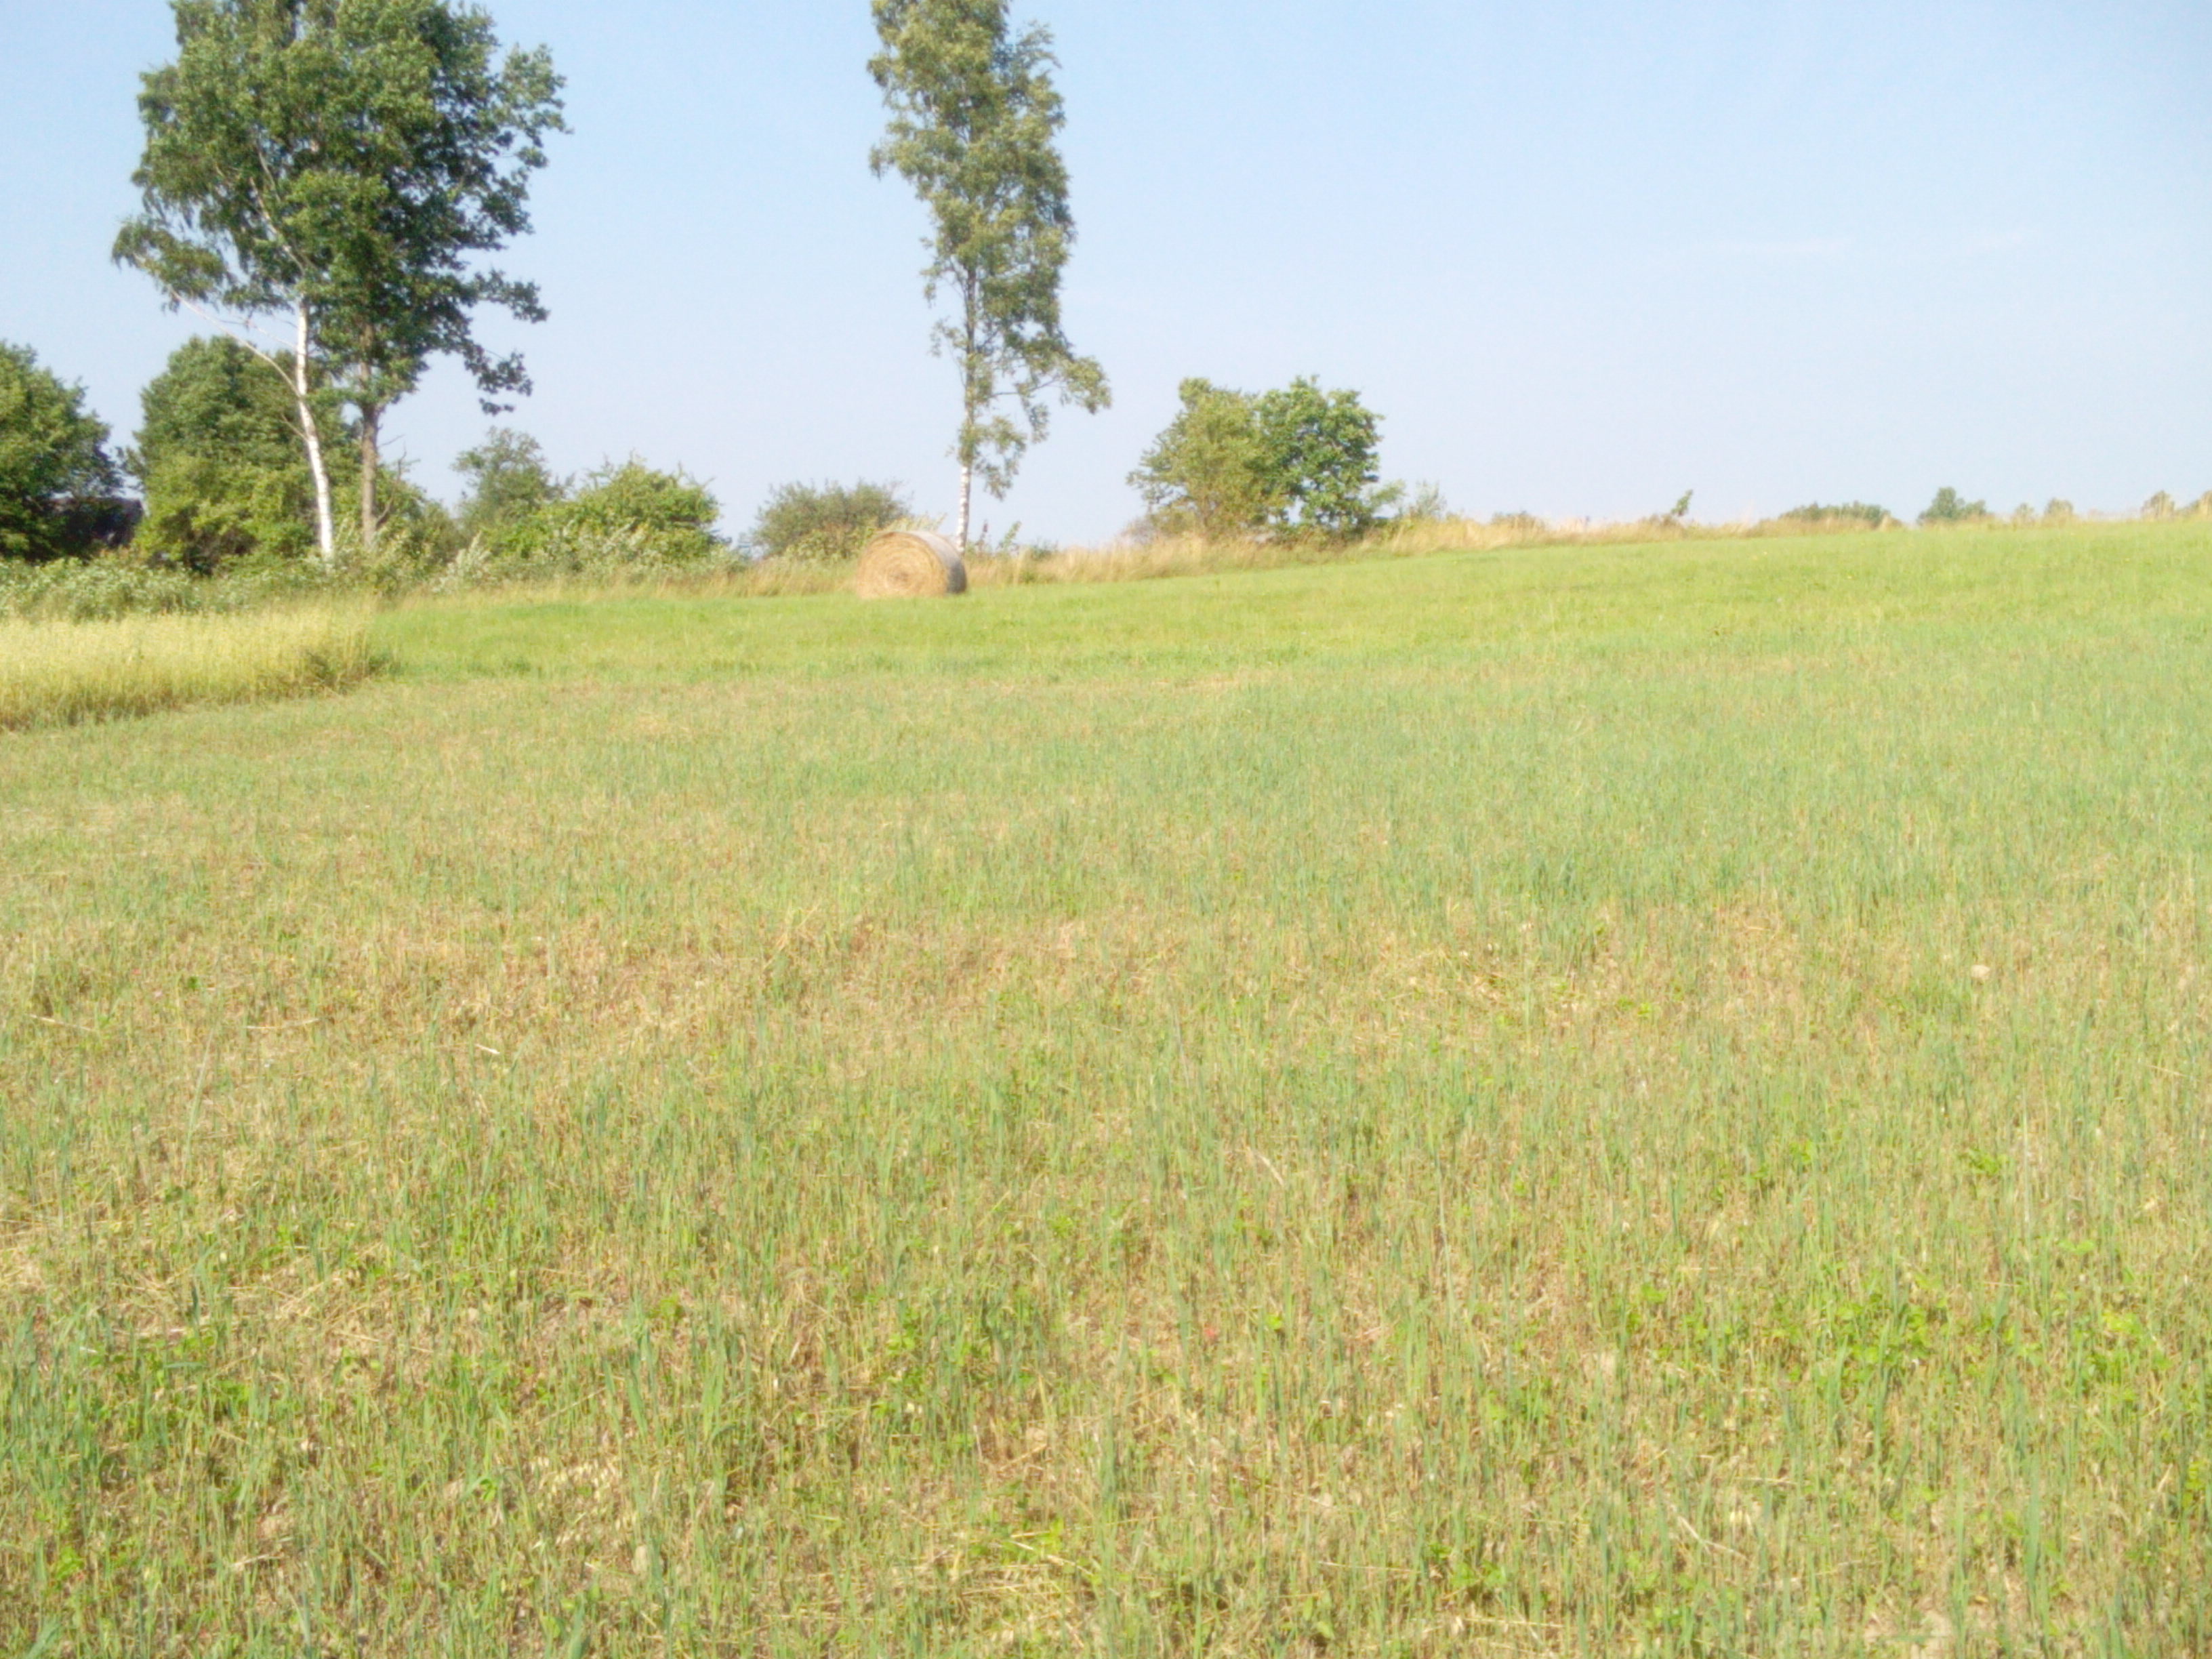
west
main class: Cropland
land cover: Mixed cereals for fodder
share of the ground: > 75 %
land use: Agriculture (excluding fallow land and kitchen gardens)
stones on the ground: < 10 %
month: August
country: LV
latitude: 56.9069
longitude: 21.6862
